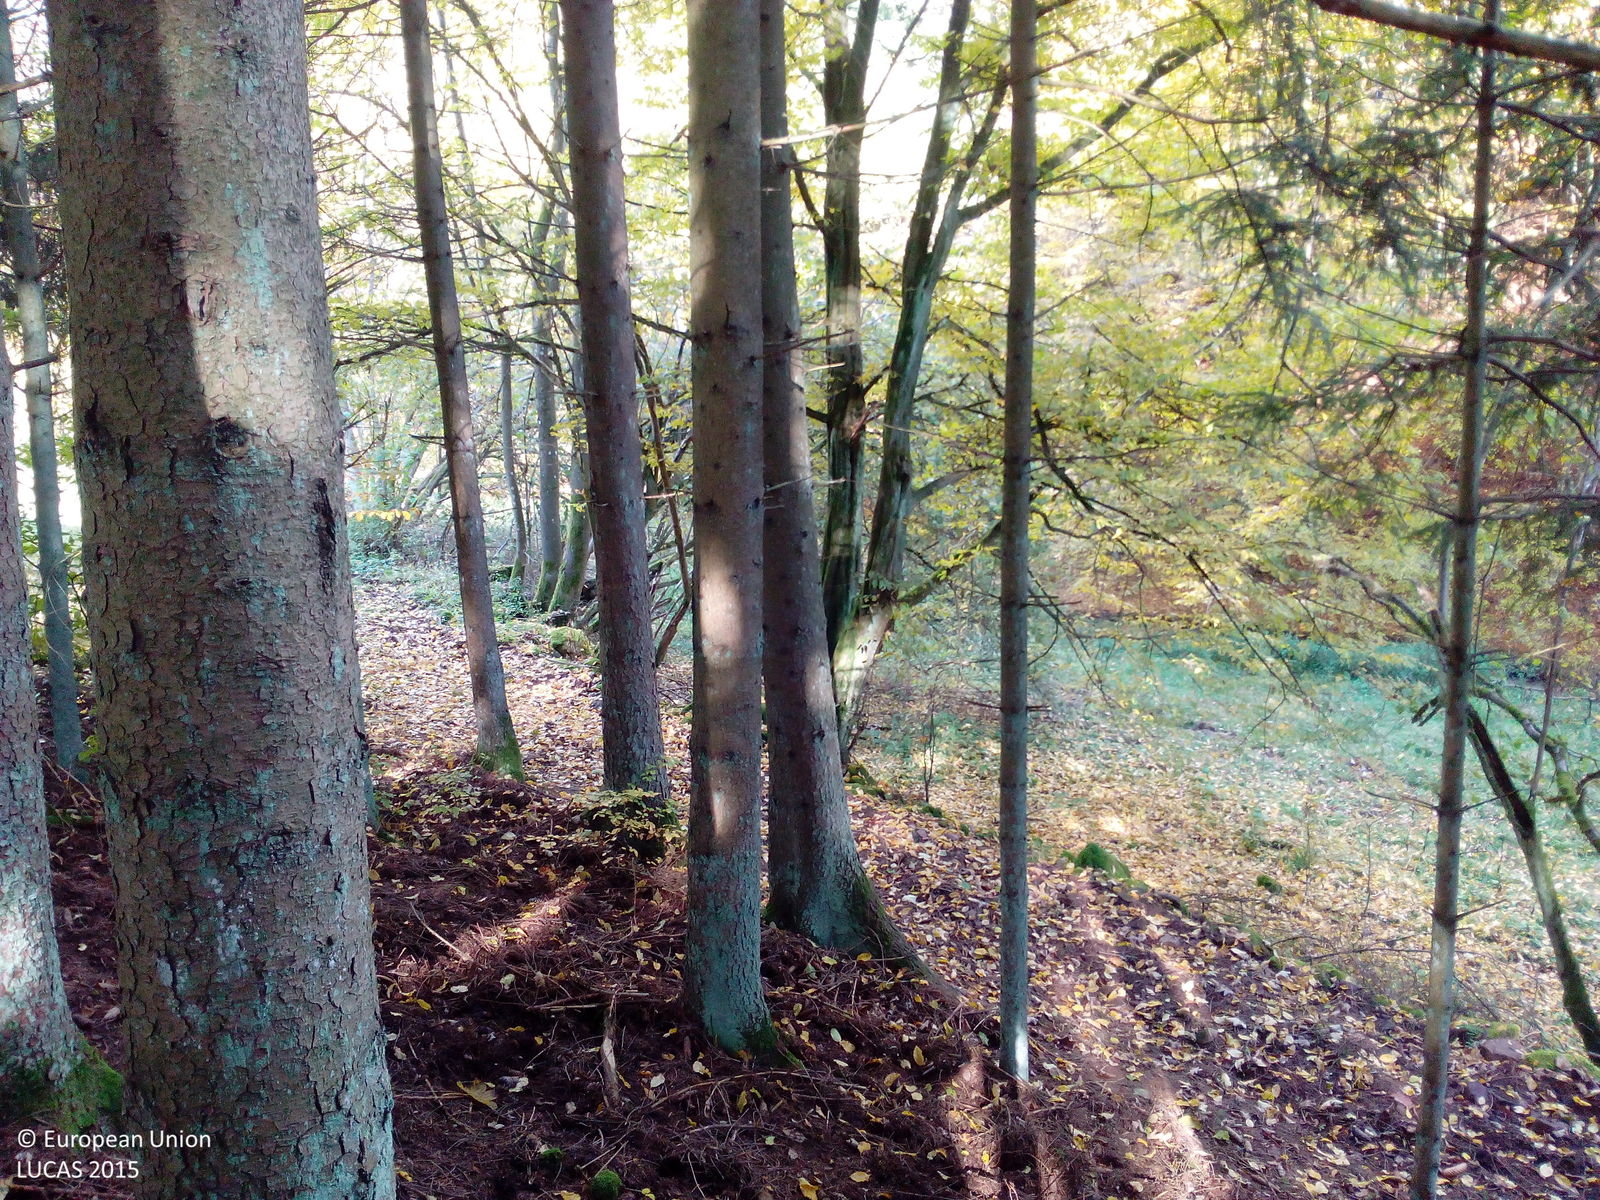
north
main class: Woodland
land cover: Spruce dominated coniferous woodland
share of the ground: 50 - 75 %
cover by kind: coniferous forest trees 65 %, unconsolidated bare surface 15 %, lichens and mosses 10 %, broadleaved forest trees 5 %, shrubs 5 %
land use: Forestry
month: October
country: DE
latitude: 50.3460
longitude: 9.8736
